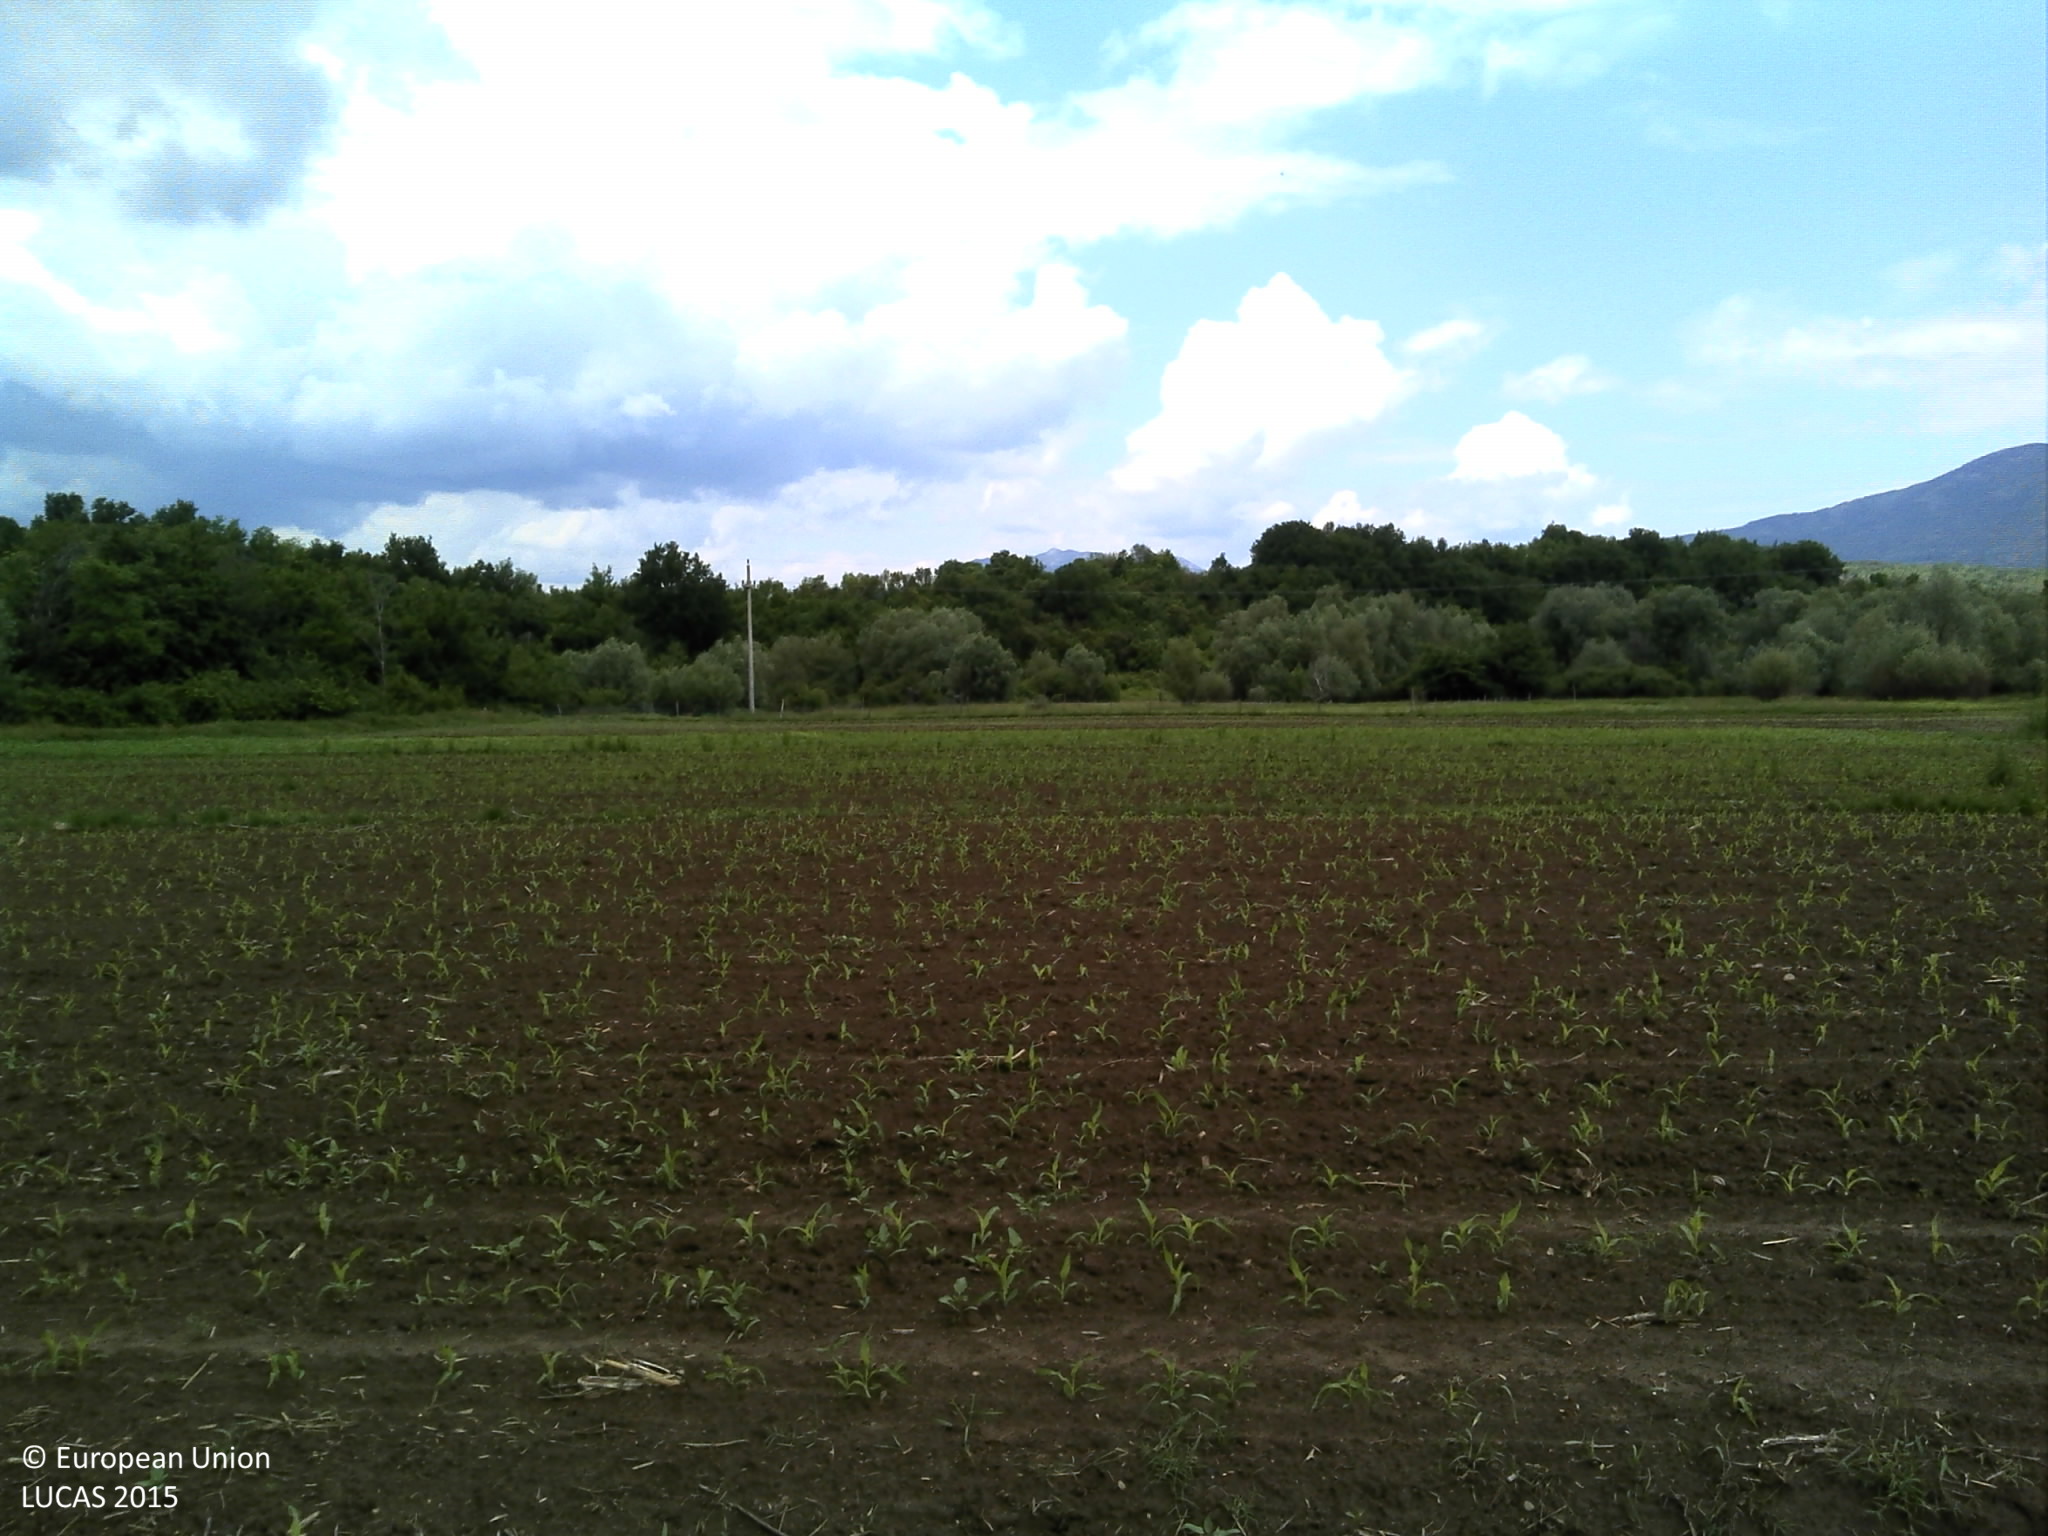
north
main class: Cropland
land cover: Maize
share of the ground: < 10 %
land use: Agriculture (excluding fallow land and kitchen gardens)
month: May
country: HR
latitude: 44.0374
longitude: 16.2194
